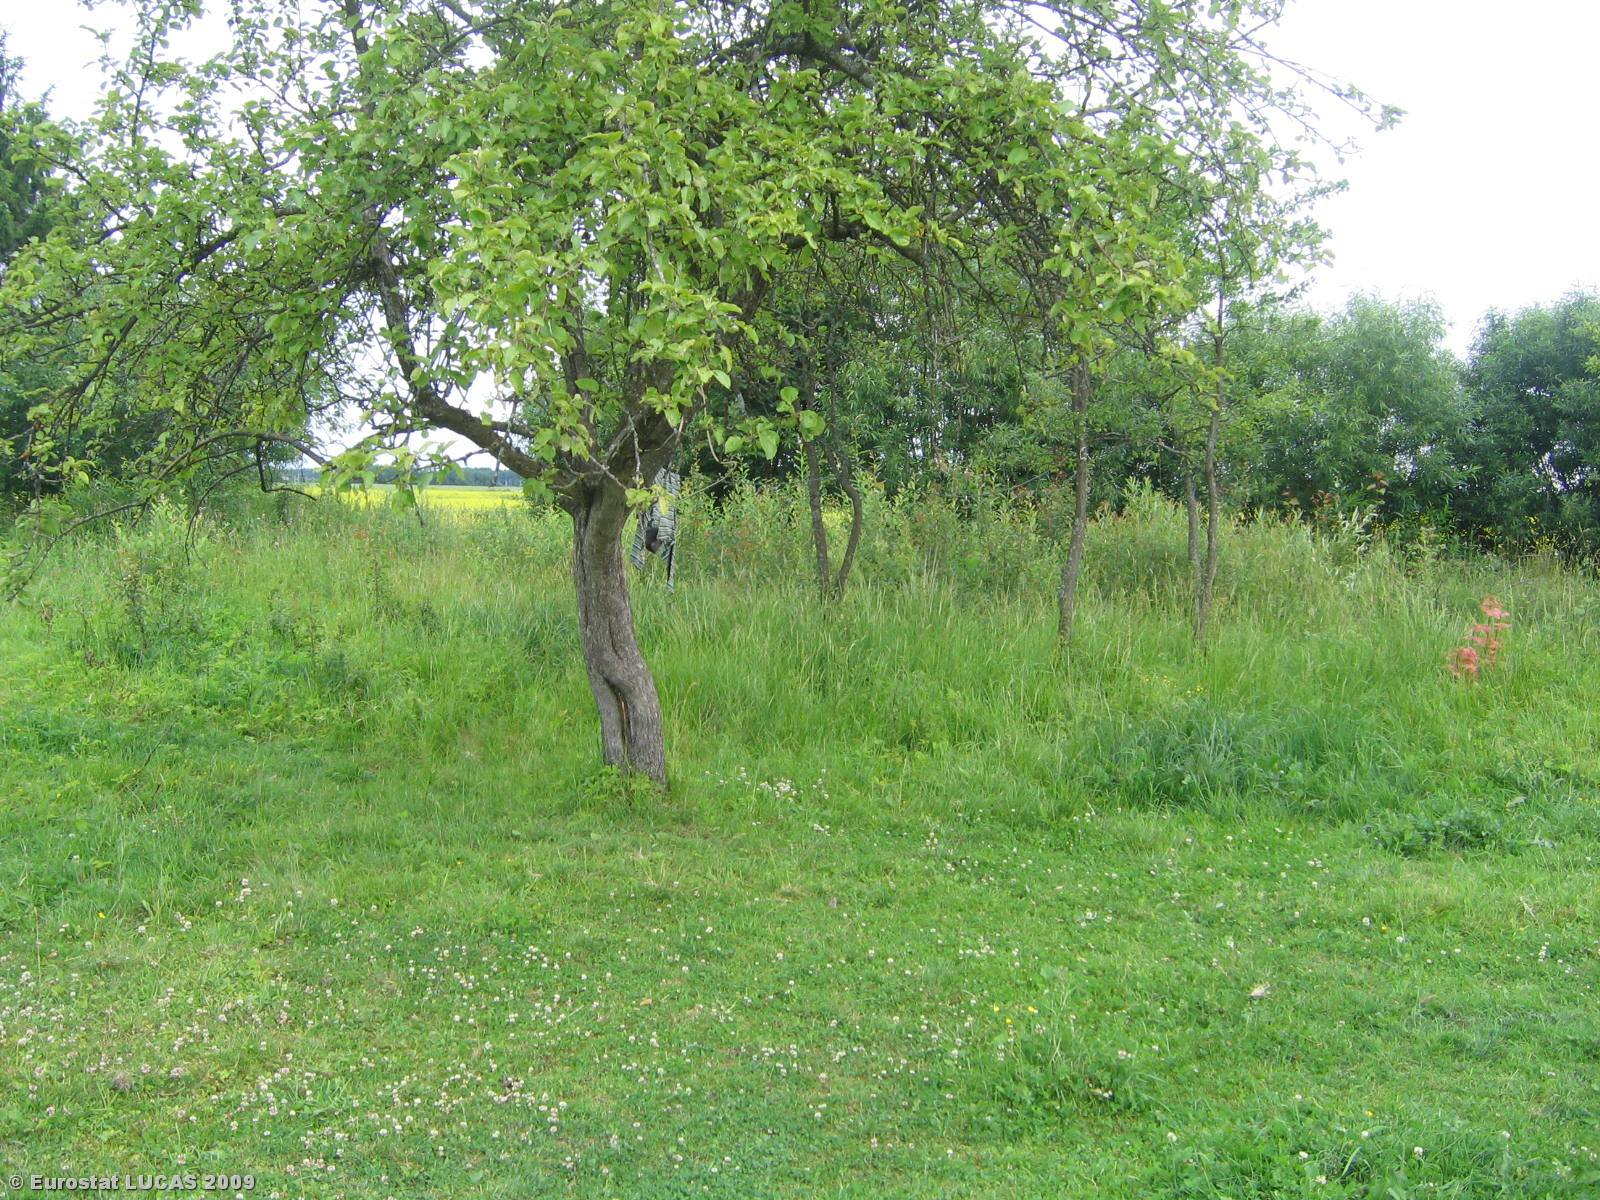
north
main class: Grassland
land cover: Grassland with sparse tree/shrub cover
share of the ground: > 75 %
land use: Residential
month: July
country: LT
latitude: 55.2763
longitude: 22.7376
